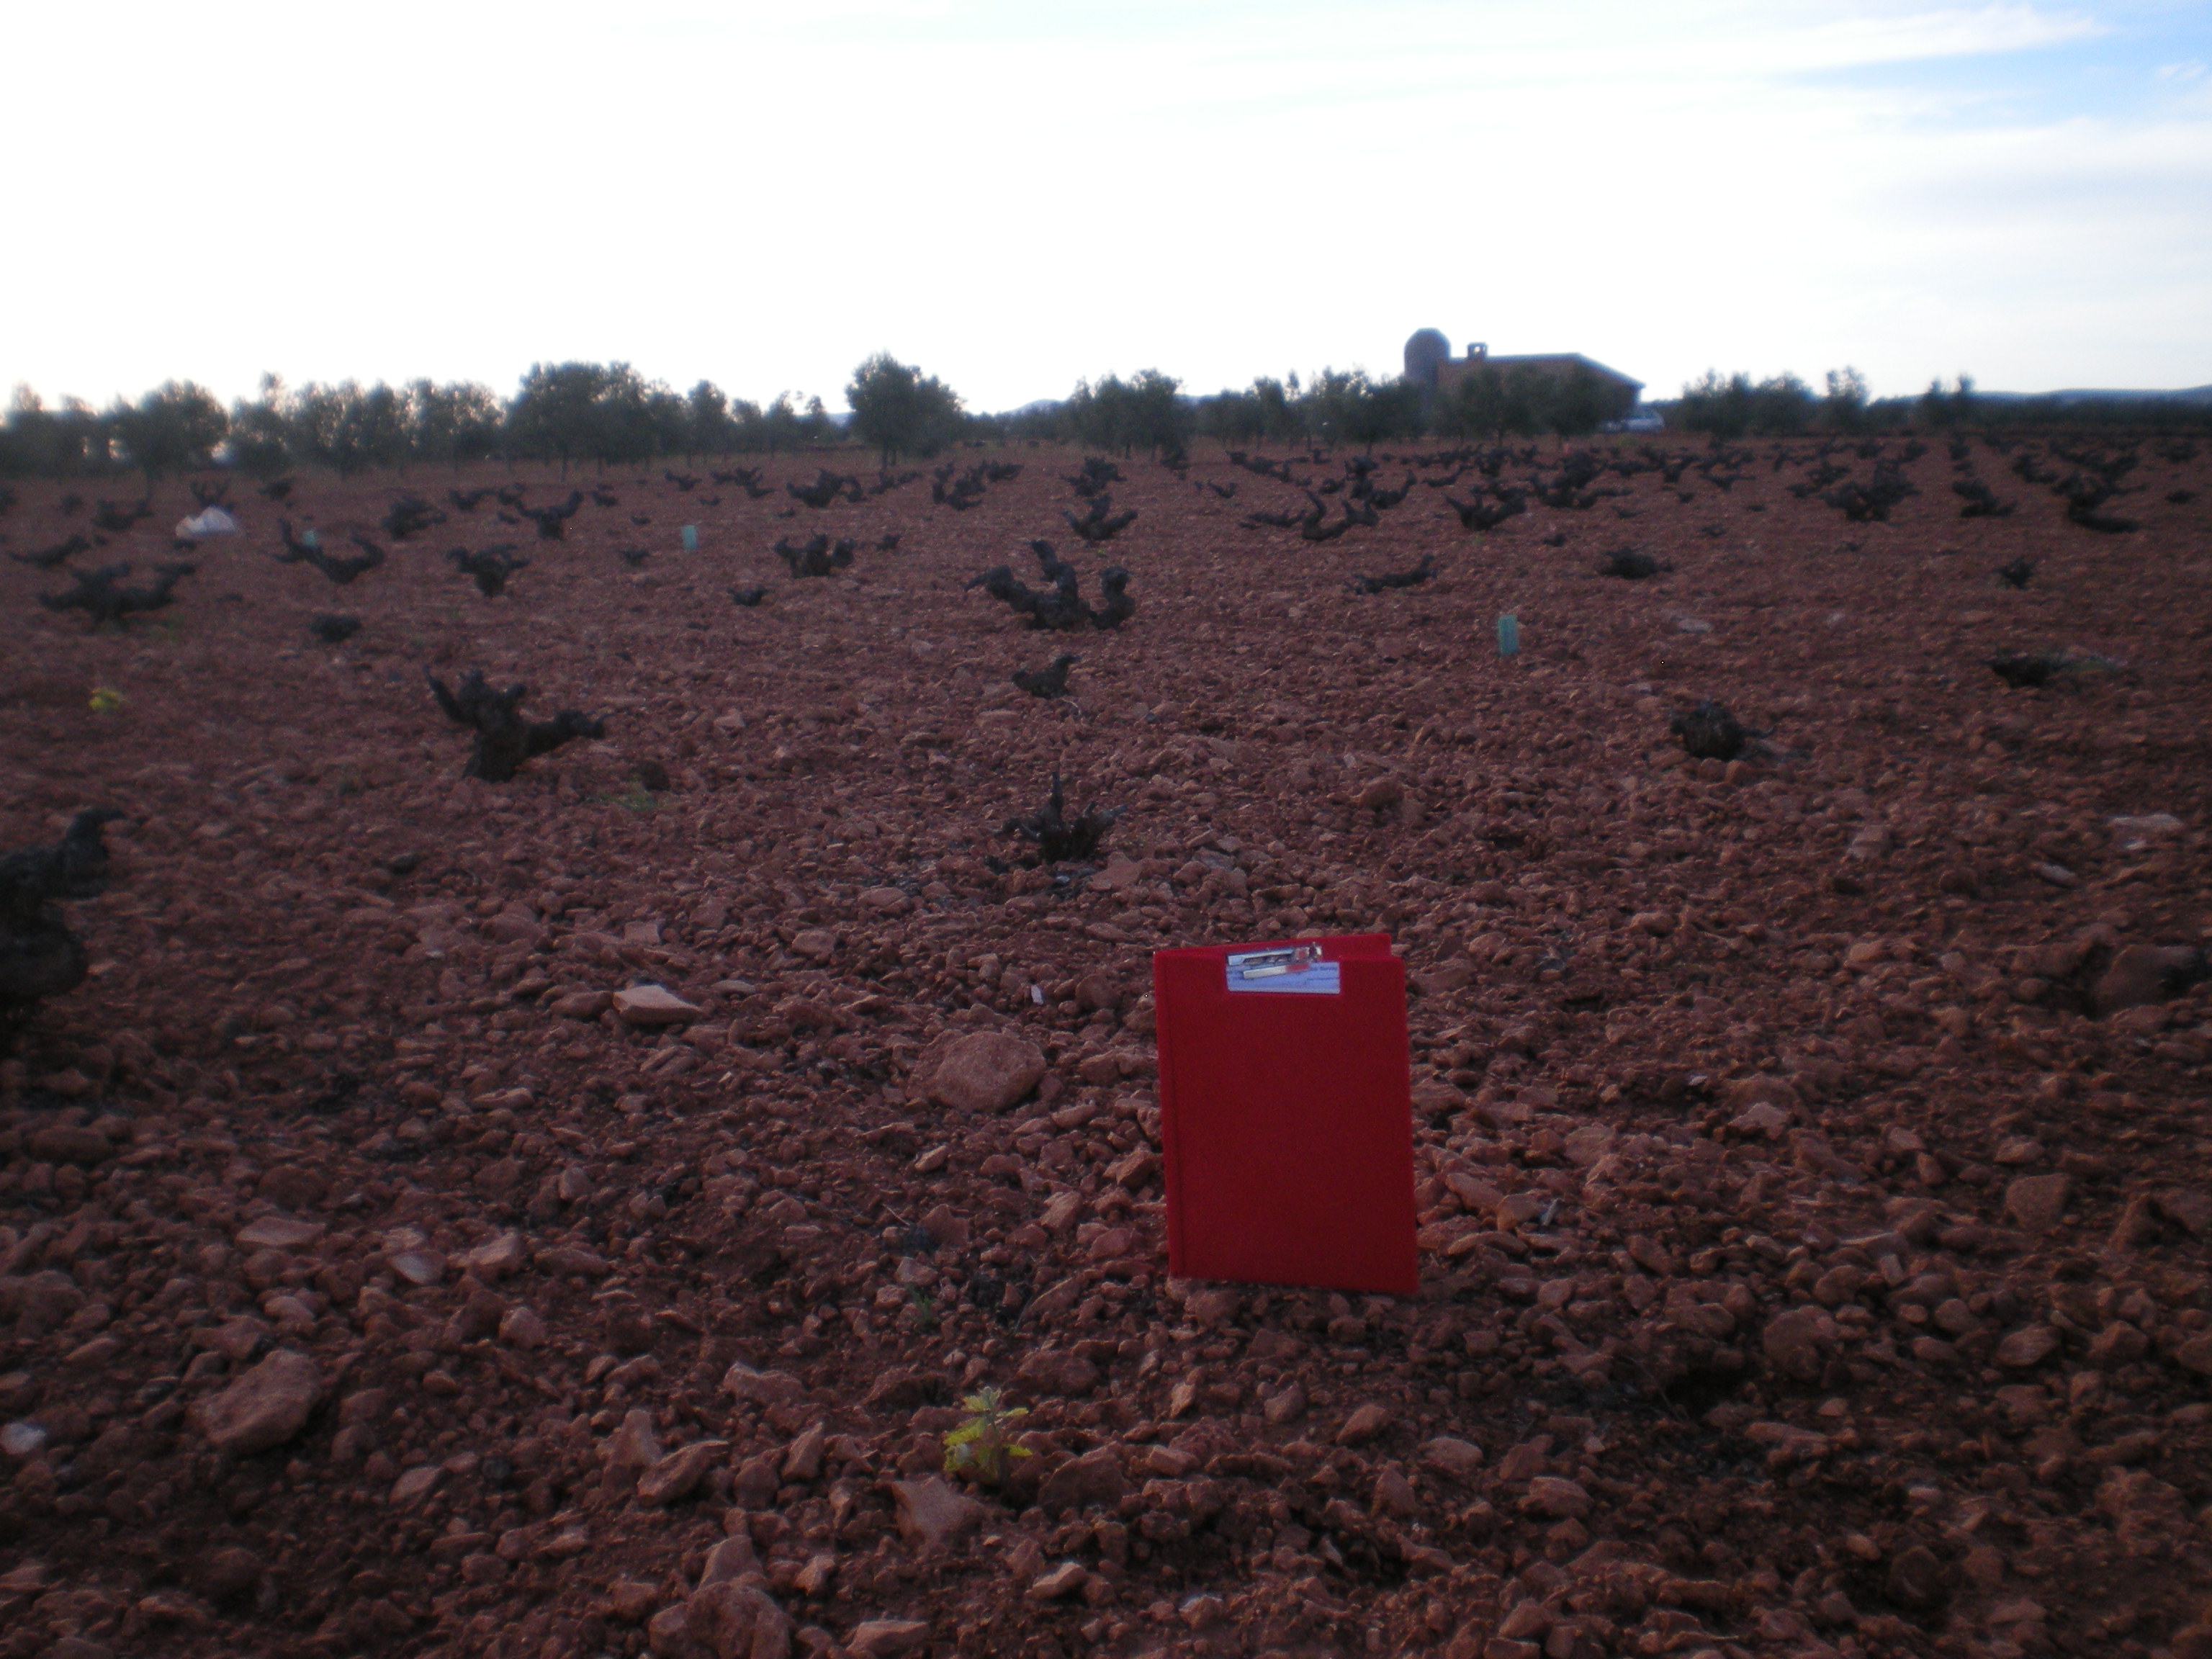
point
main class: Cropland
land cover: Vineyards
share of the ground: < 10 %
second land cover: Other bare soil
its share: > 75 %
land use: Agriculture (excluding fallow land and kitchen gardens)
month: April
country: ES
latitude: 38.7538
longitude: -3.1609
